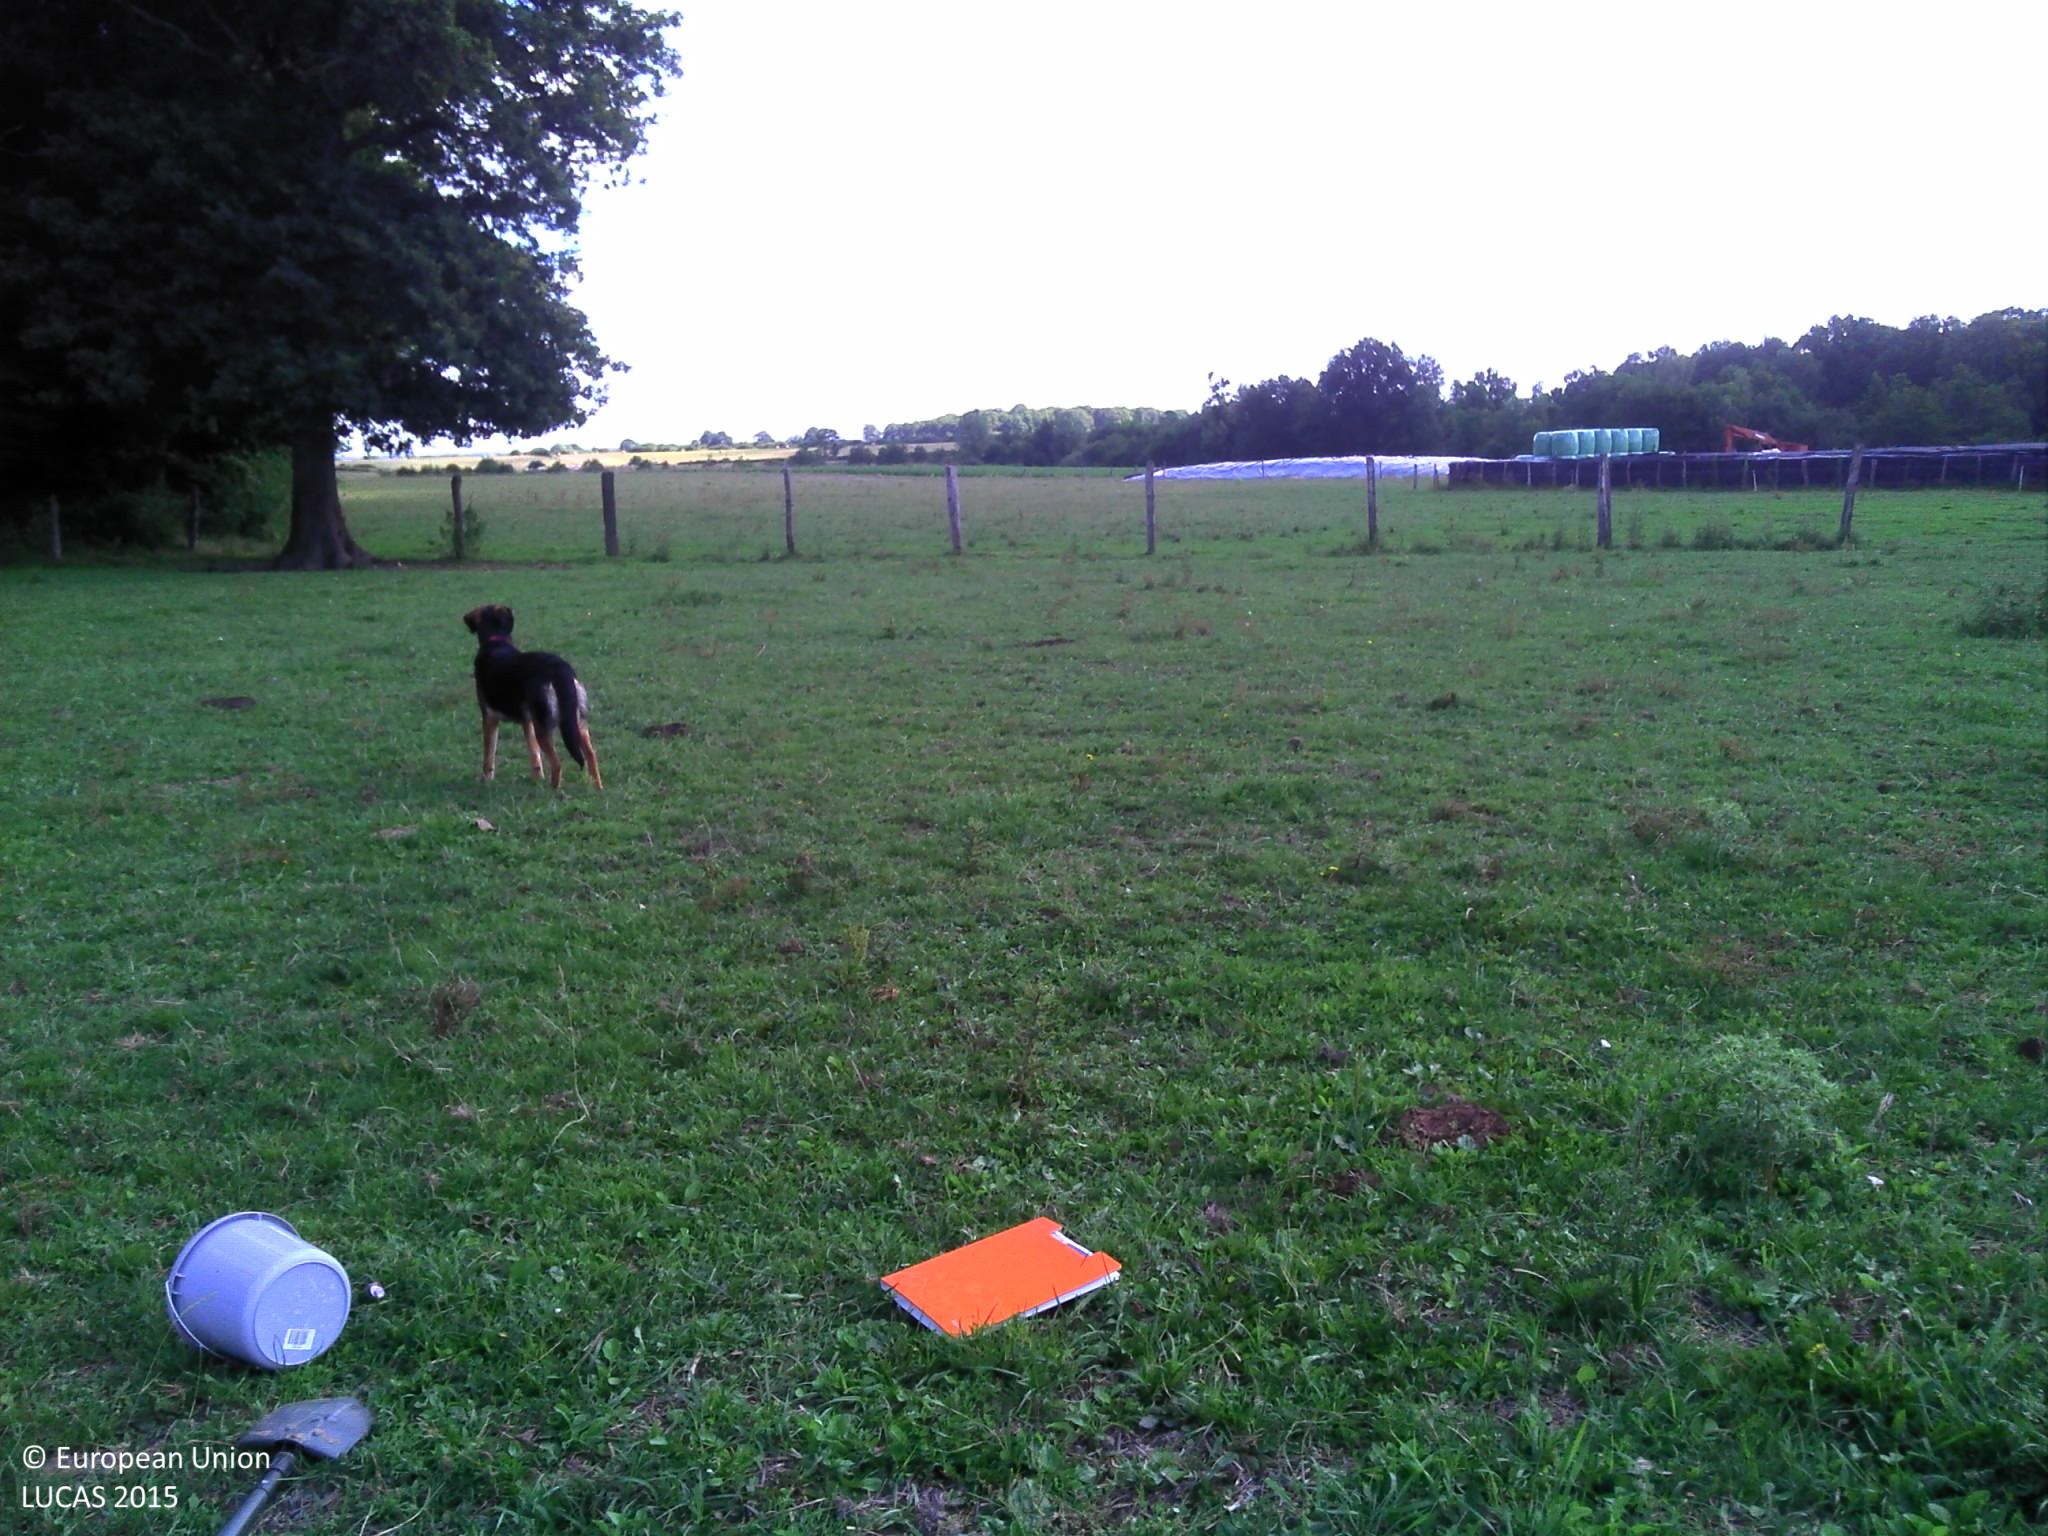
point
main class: Grassland
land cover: Grassland without tree/shrub cover
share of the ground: > 75 %
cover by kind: herbaceous plants 100 %
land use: Agriculture (excluding fallow land and kitchen gardens)
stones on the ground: < 10 %
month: June
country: FR
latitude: 46.7180
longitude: 3.5749
